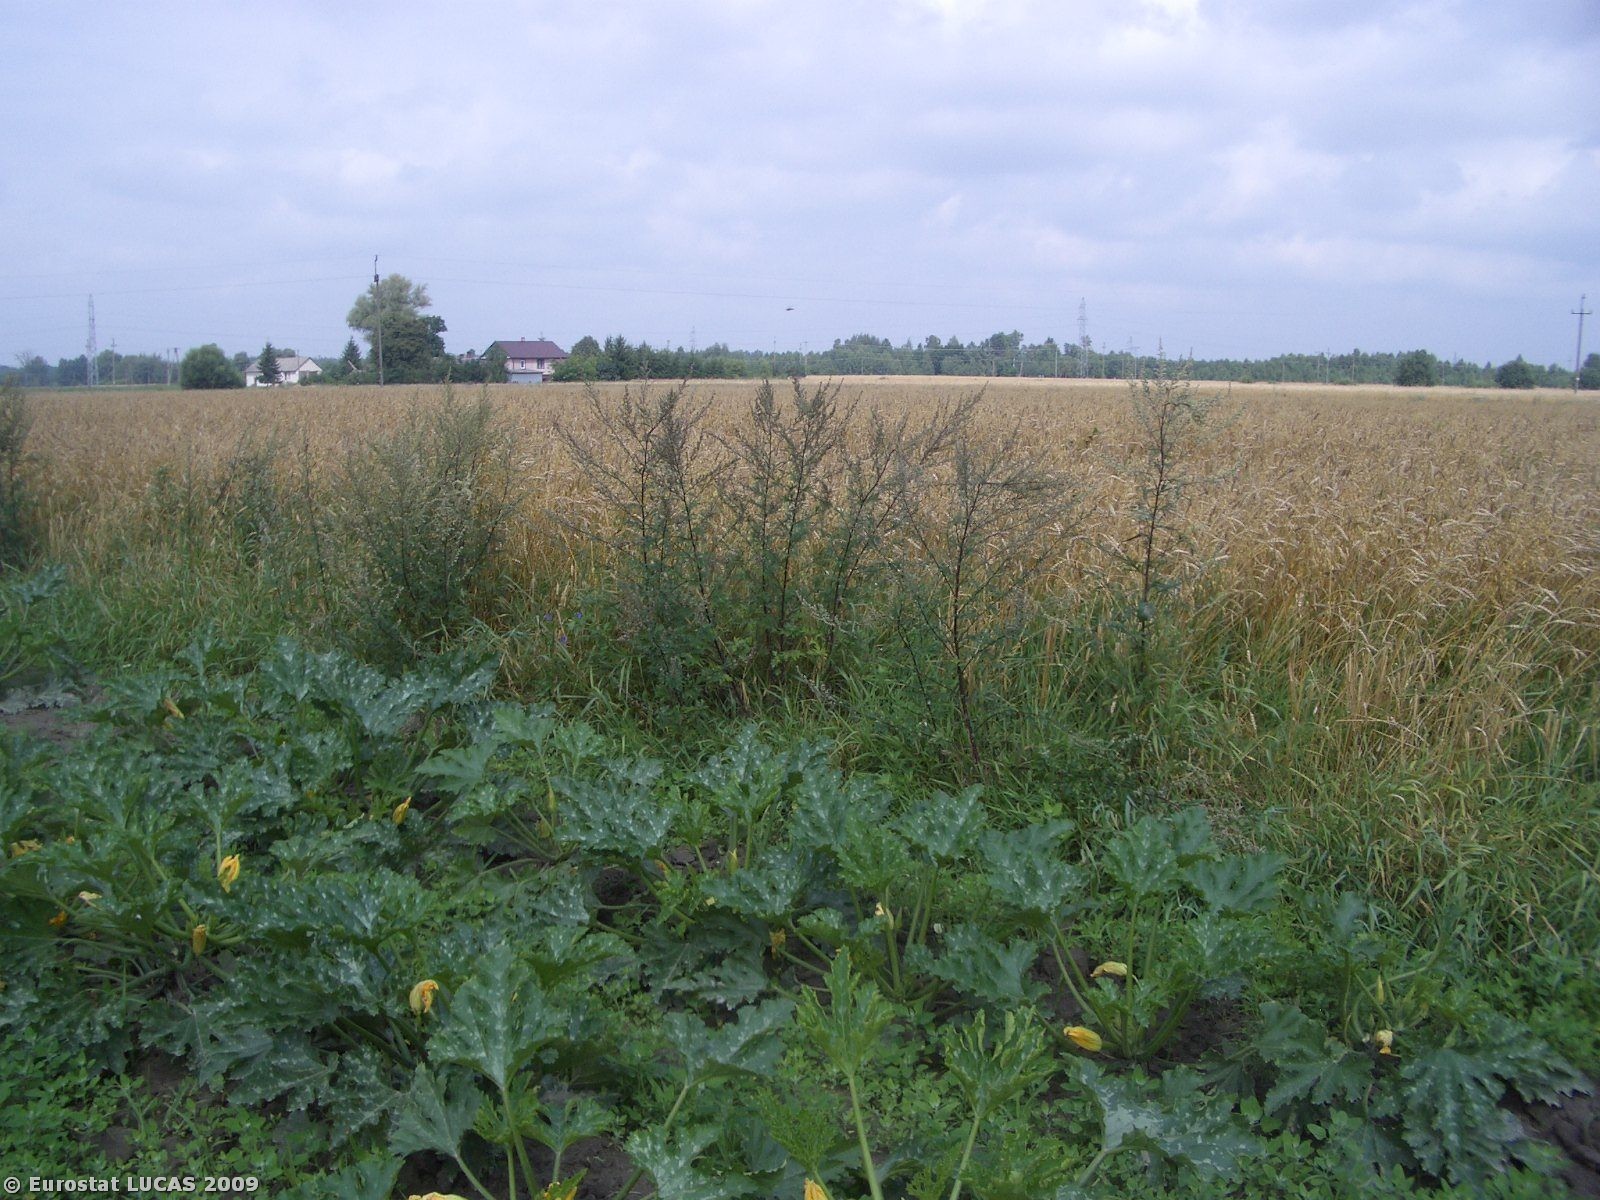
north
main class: Cropland
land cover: Other fresh vegetables
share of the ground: 50 - 75 %
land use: Agriculture (excluding fallow land and kitchen gardens)
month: August
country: PL
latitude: 51.7999
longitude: 23.2023
